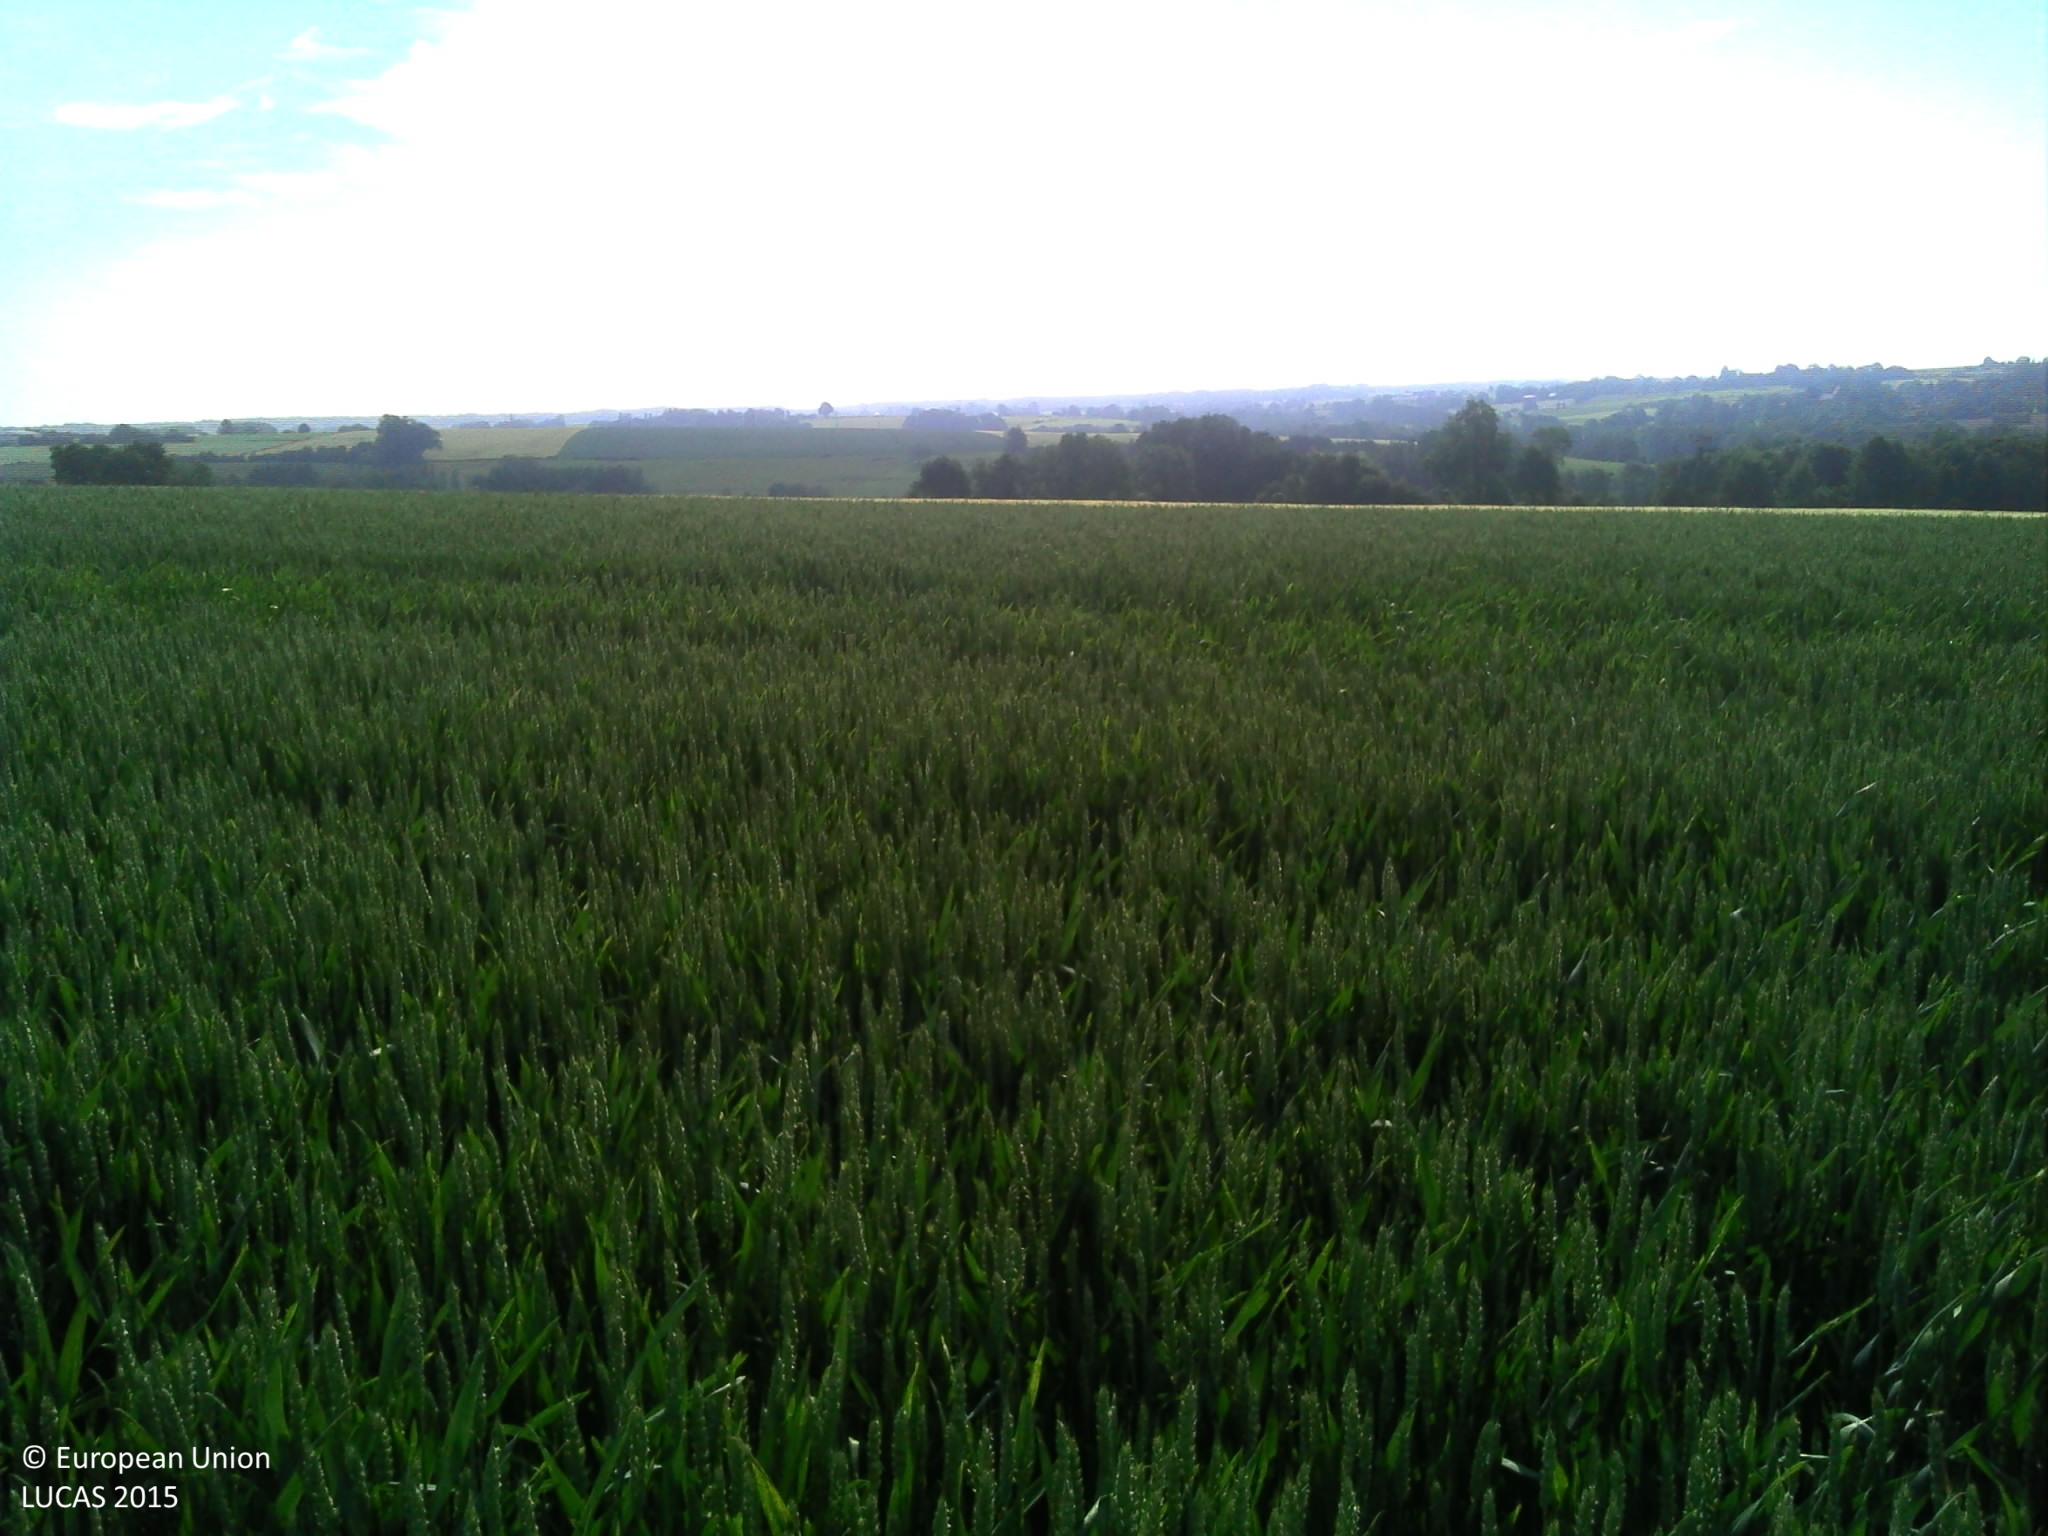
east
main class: Cropland
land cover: Common wheat
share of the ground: > 75 %
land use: Agriculture (excluding fallow land and kitchen gardens)
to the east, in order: Common wheat; Barley; Common wheat
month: June
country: FR
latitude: 49.8116
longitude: 4.0329
